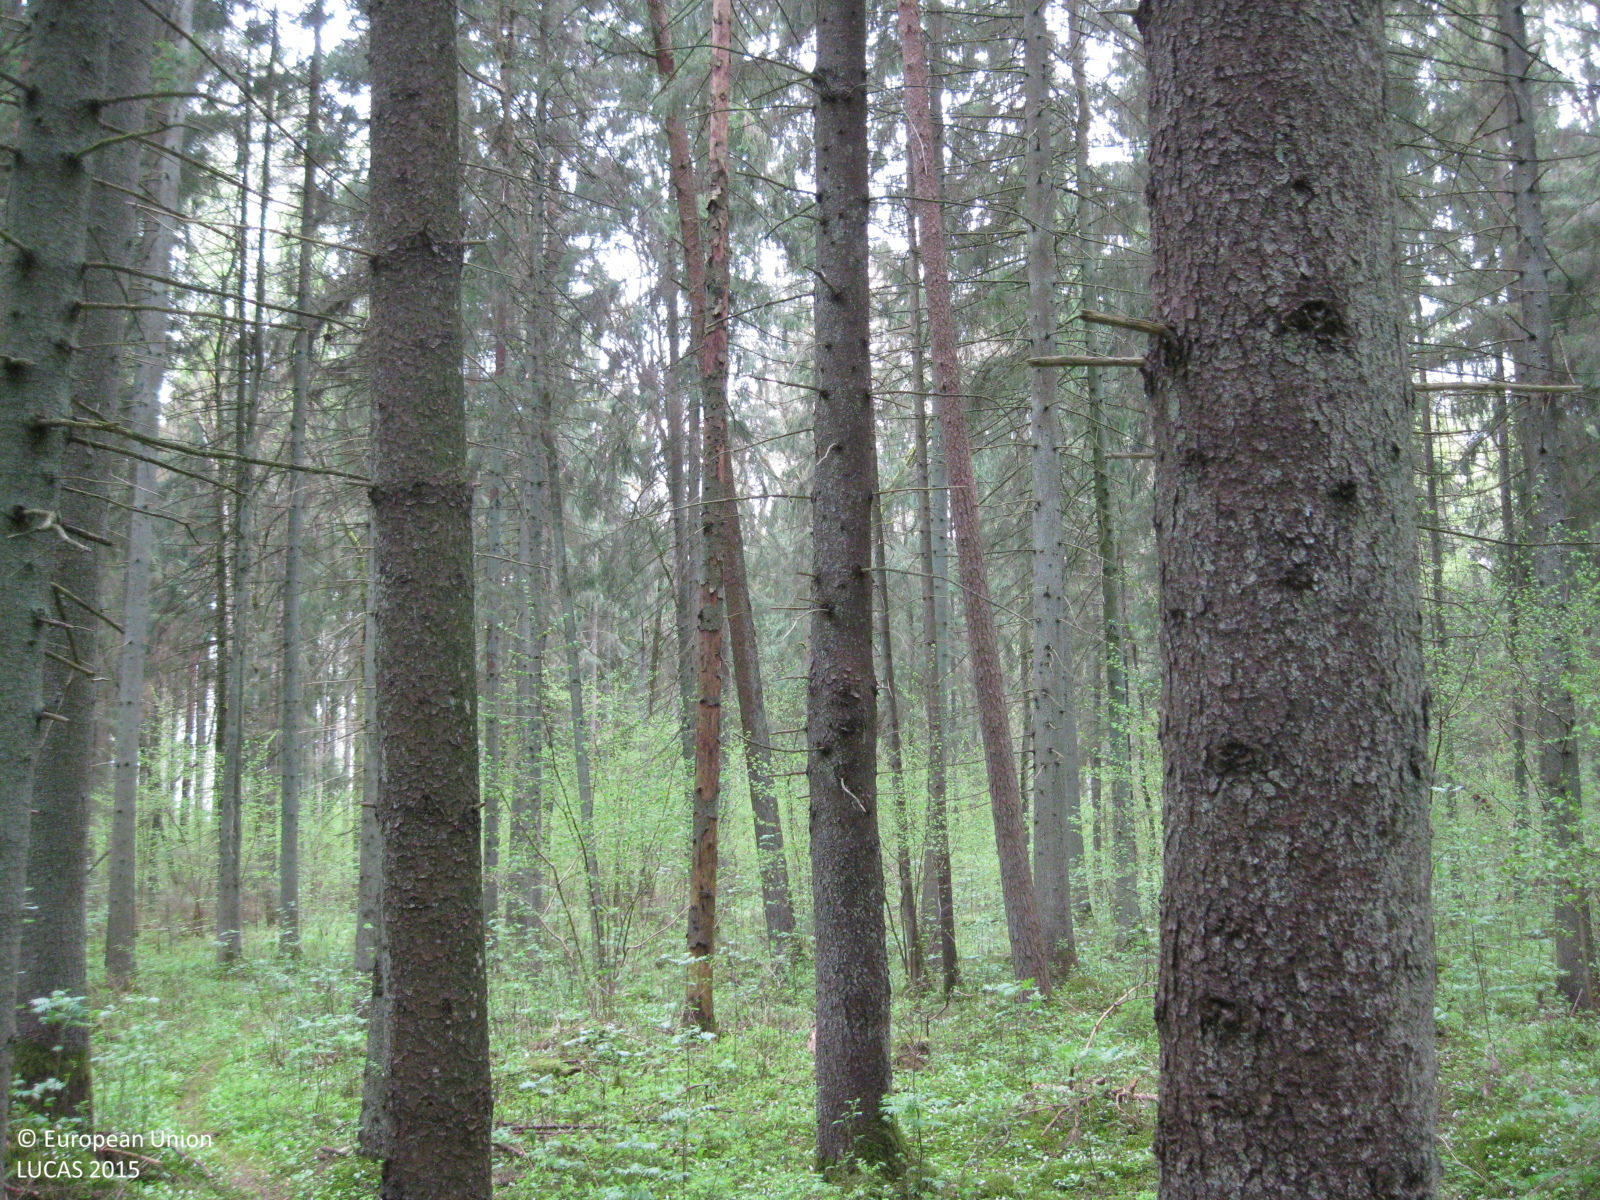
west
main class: Woodland
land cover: Spruce dominated coniferous woodland
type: hemiboreal forest and nemoral coniferous forest and mixed broadleaved-coniferous forest
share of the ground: > 75 %
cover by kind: coniferous forest trees 75 %, lichens and mosses 10 %, broadleaved forest trees 5 %, shrubs 5 %, herbaceous plants 5 %
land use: Forestry
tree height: > 5 m
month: May
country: LT
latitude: 56.1519
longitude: 24.4395
